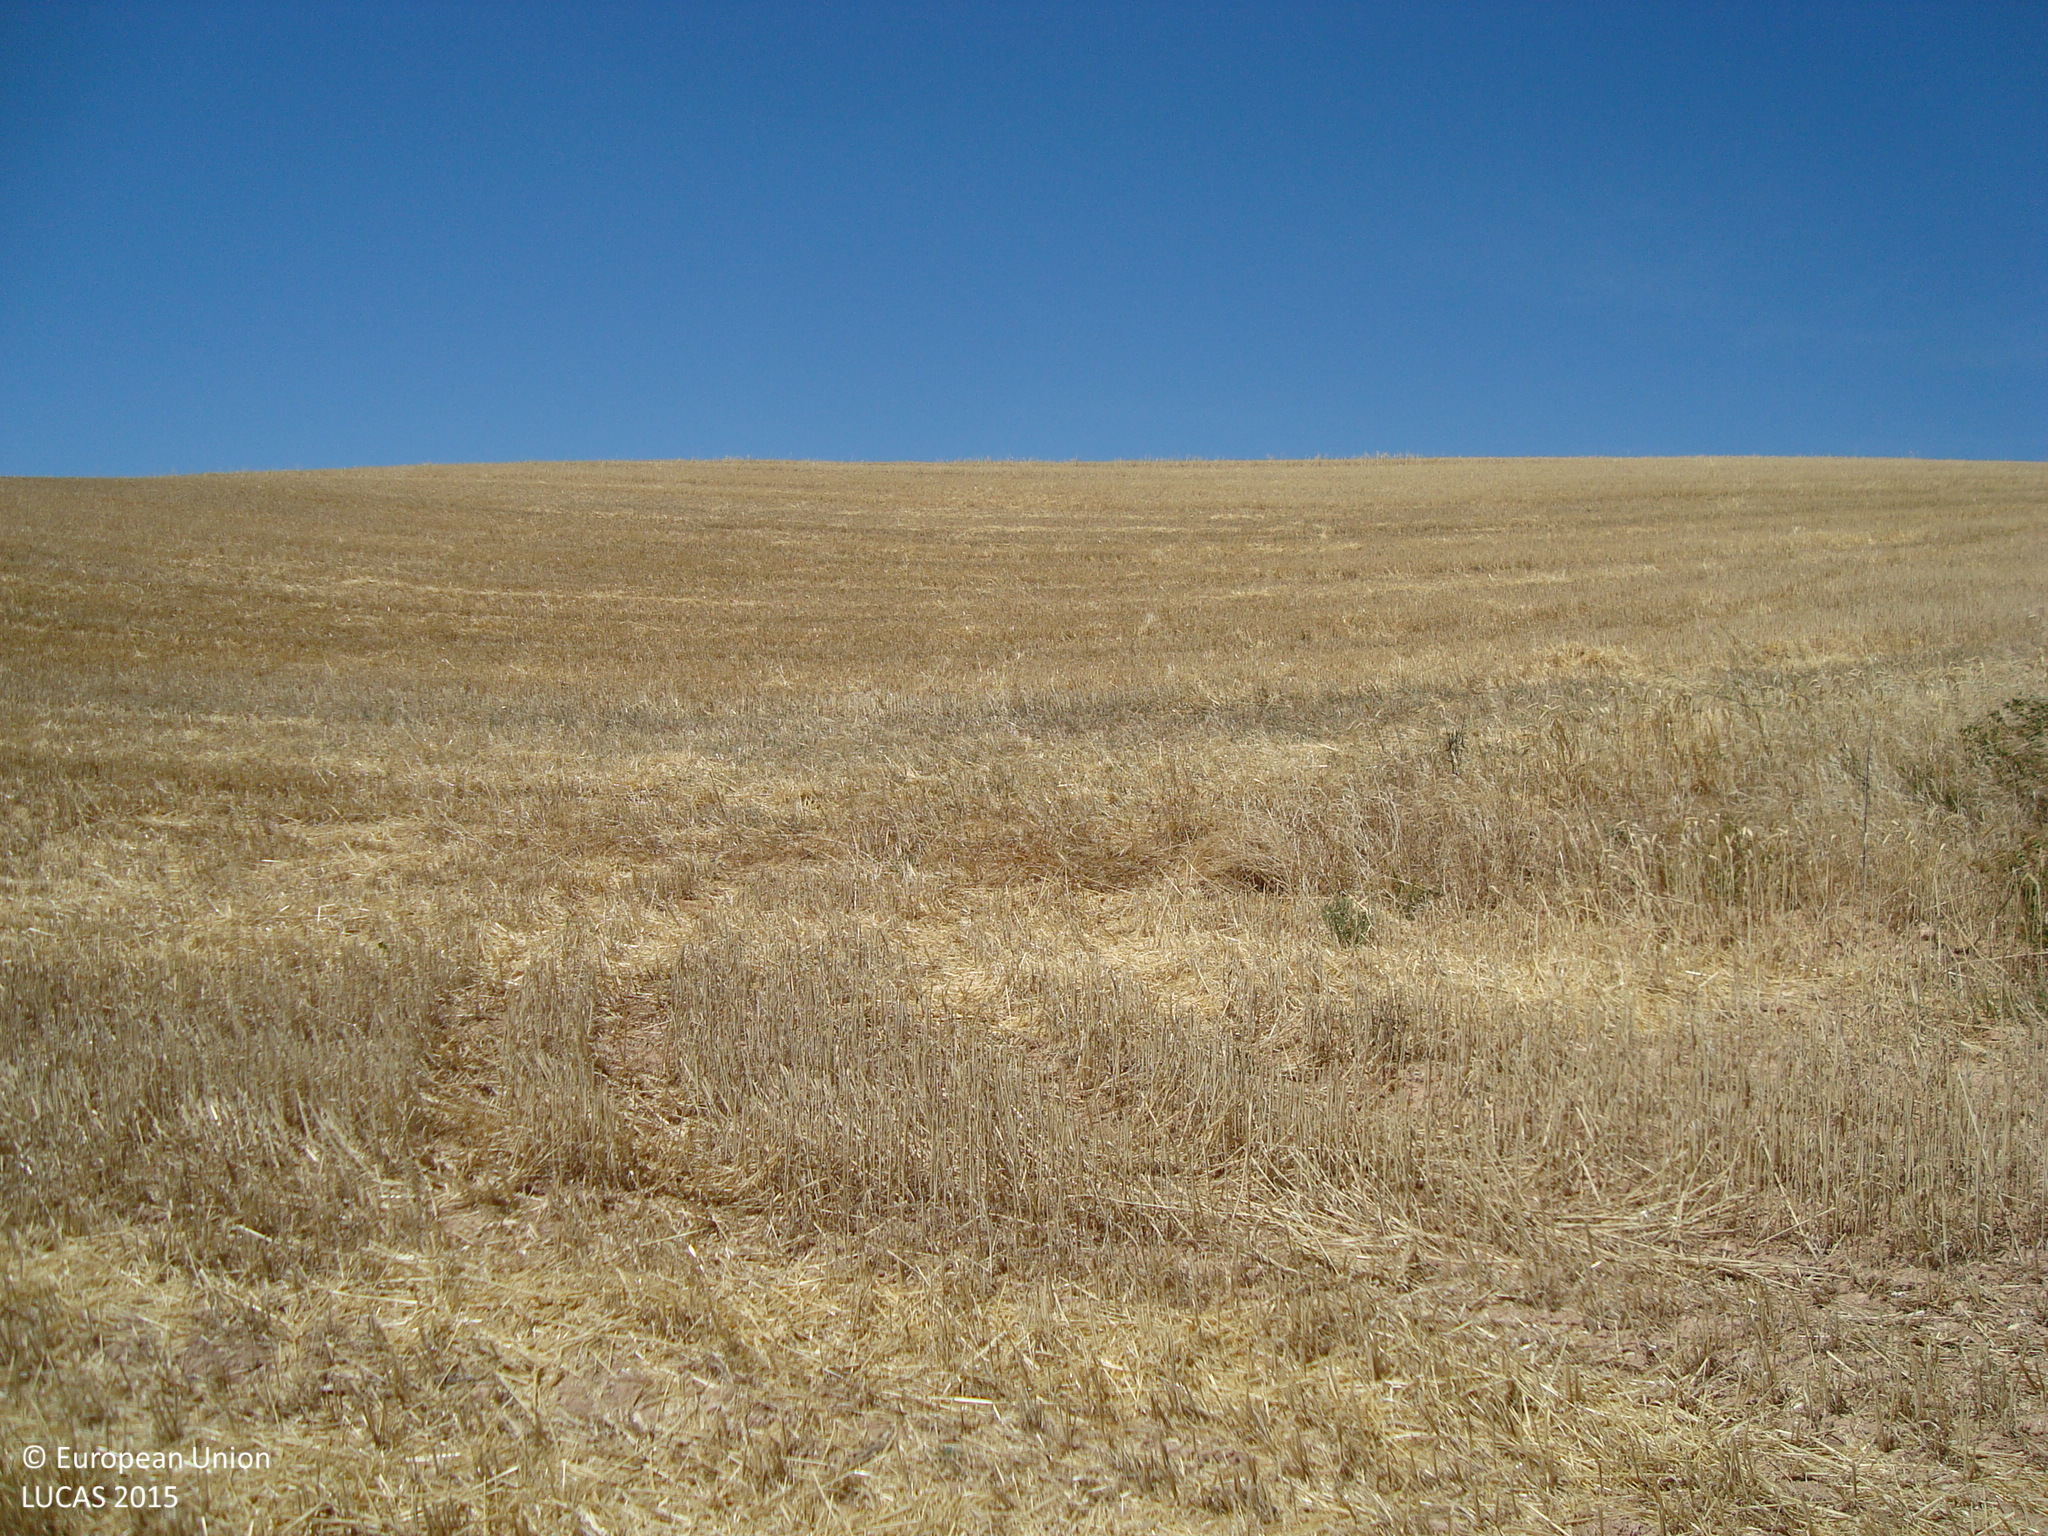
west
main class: Cropland
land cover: Common wheat
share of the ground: > 75 %
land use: Agriculture (excluding fallow land and kitchen gardens)
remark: Harvested field
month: July
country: ES
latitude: 42.0701
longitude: -3.8009
